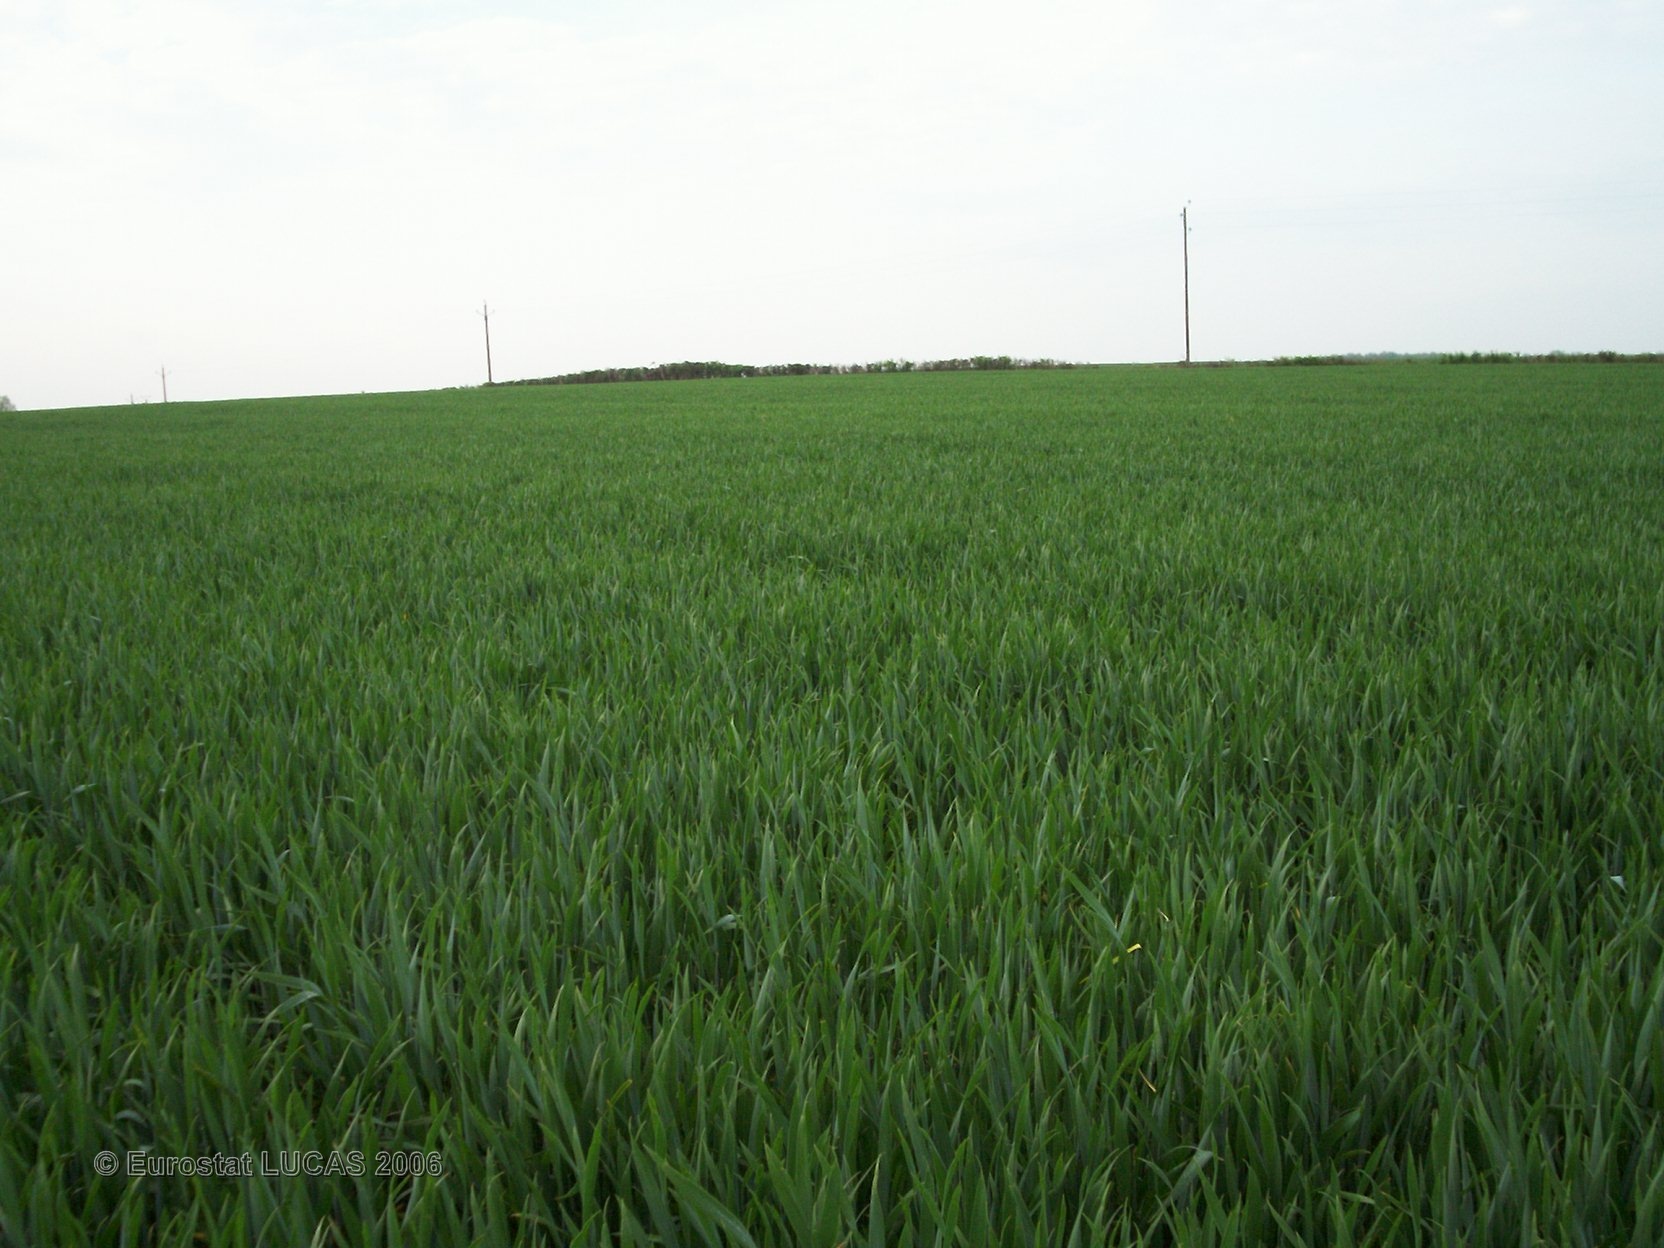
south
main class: Cropland
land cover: Common wheat
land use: Agriculture (excluding fallow land and kitchen gardens)
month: May
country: FR
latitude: 46.5844
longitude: 0.9679
